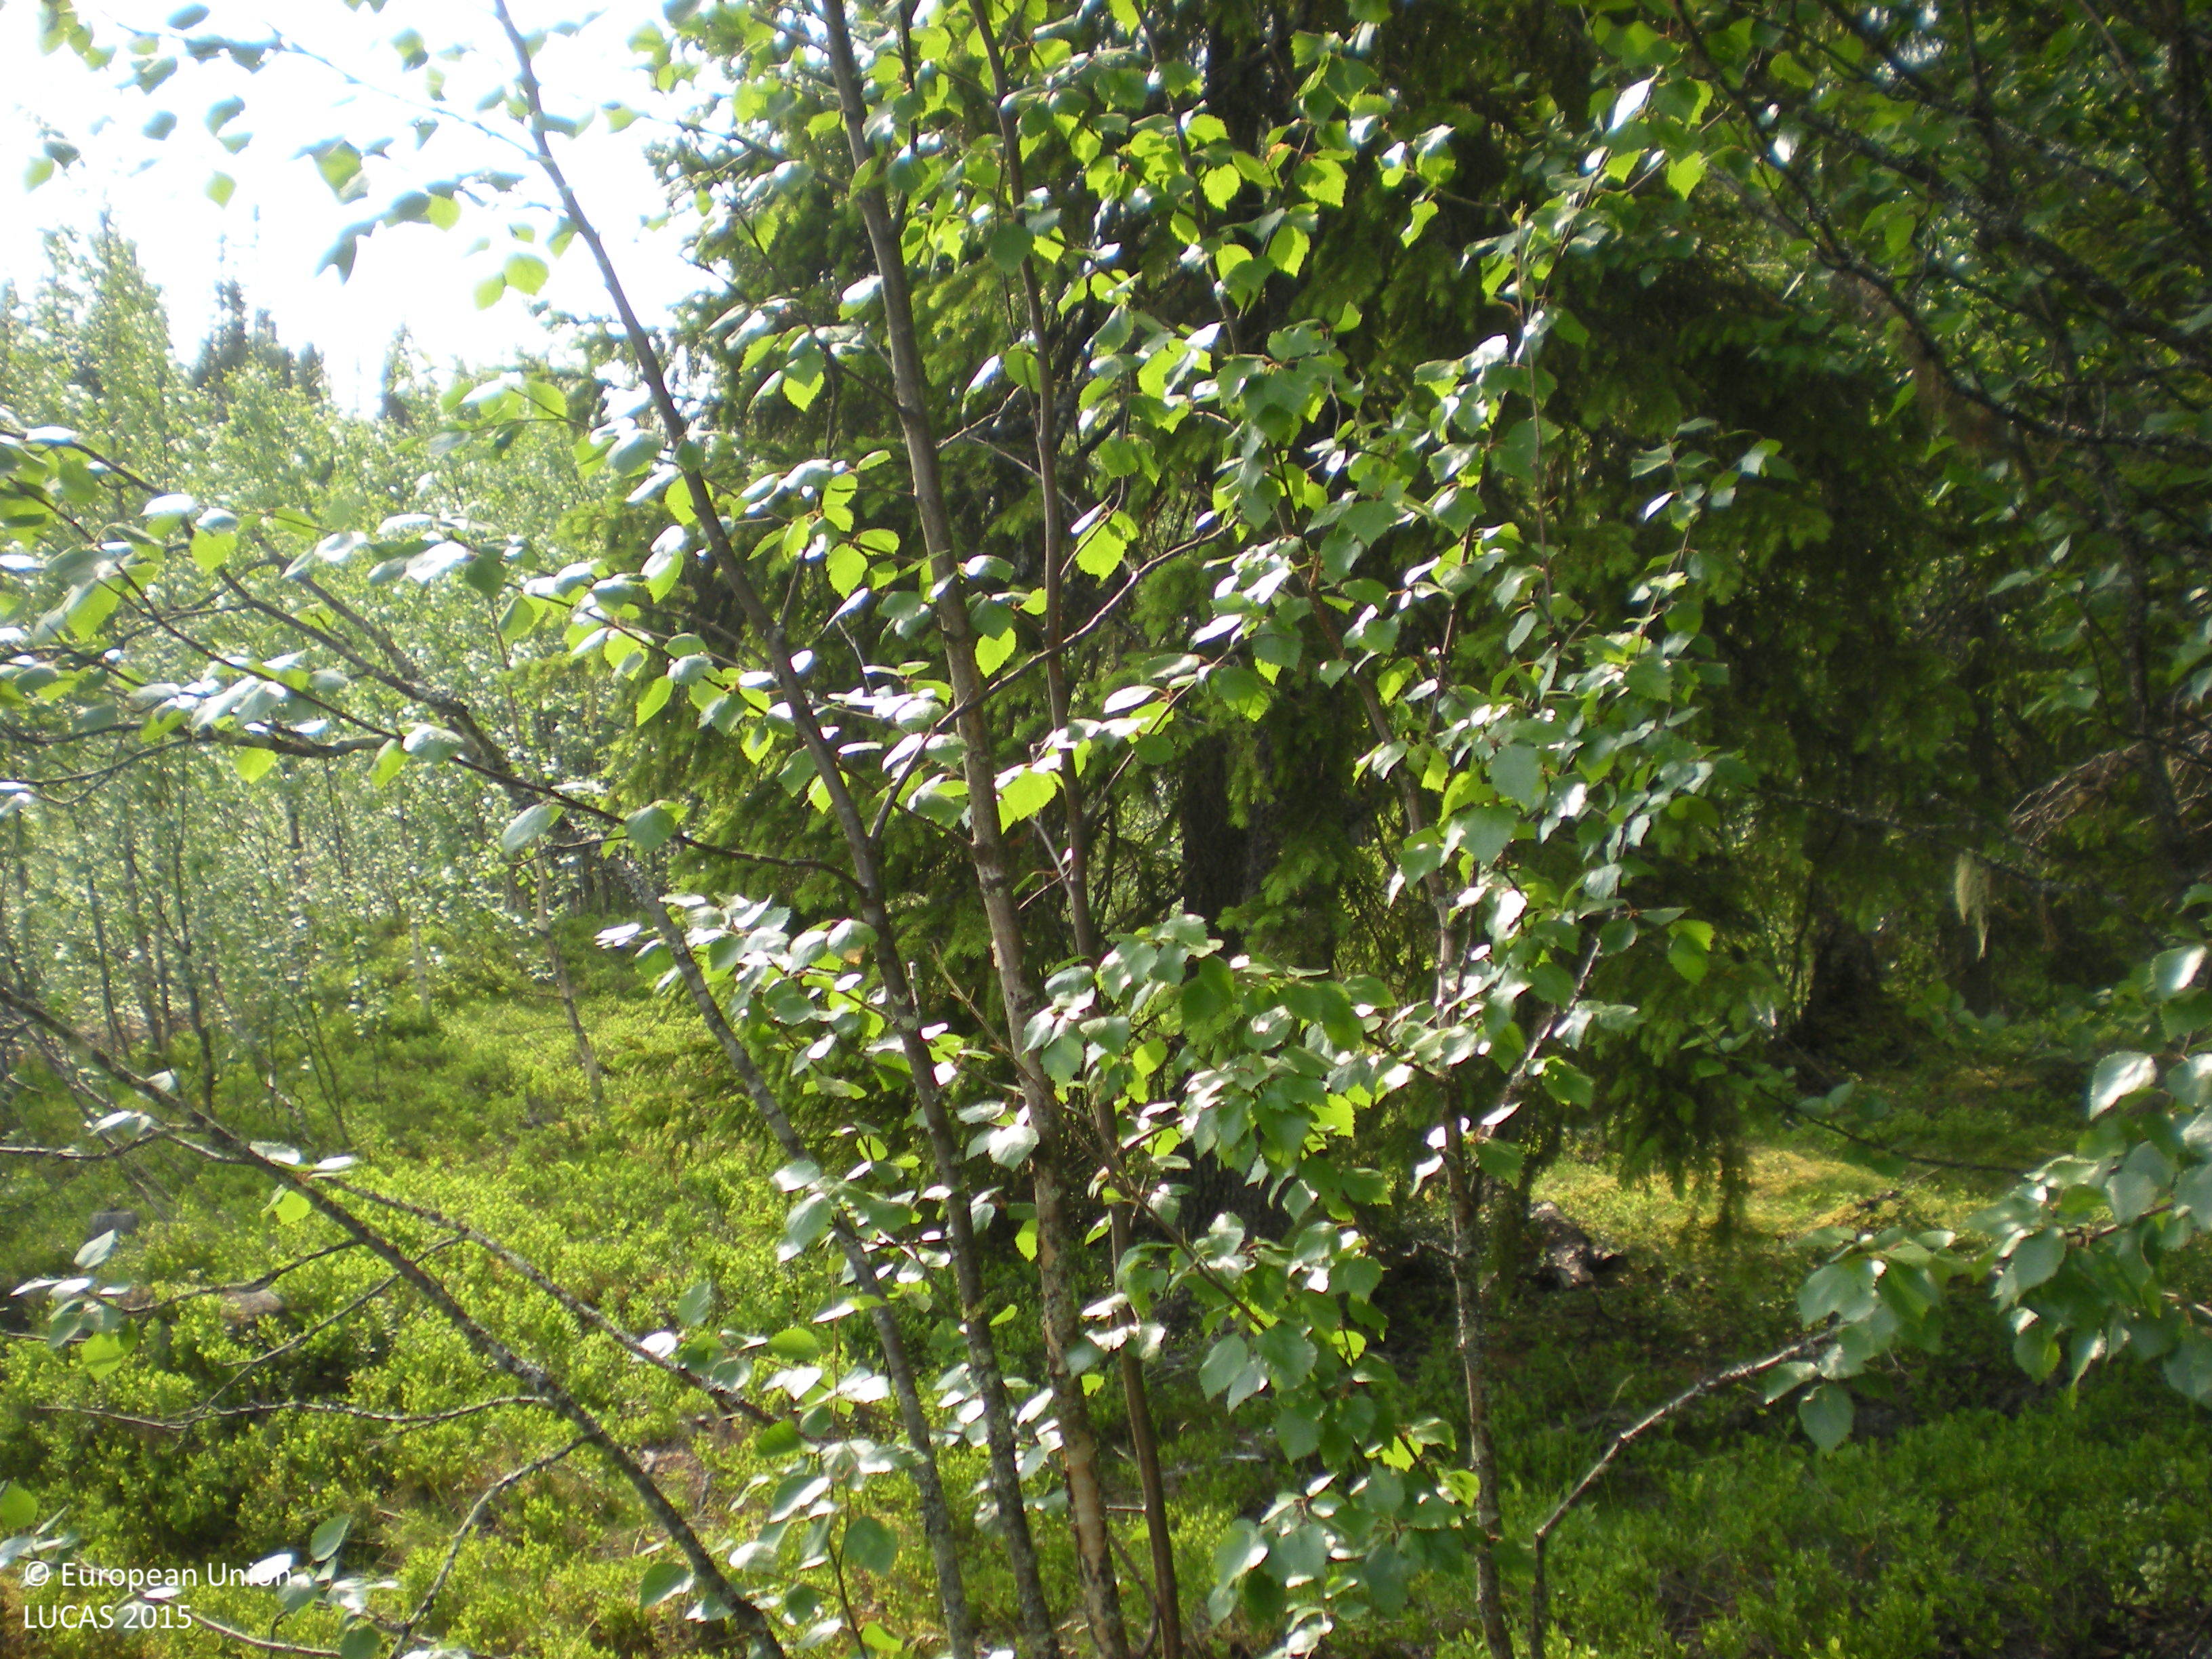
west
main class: Woodland
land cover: Spruce dominated mixed woodland
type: boreal forest
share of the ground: 50 - 75 %
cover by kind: shrubs 40 %, coniferous forest trees 35 %, broadleaved forest trees 20 %, lichens and mosses 5 %
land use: Forestry
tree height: > 5 m
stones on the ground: 10 - 25 %
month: July
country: SE
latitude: 65.4067
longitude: 16.9598
